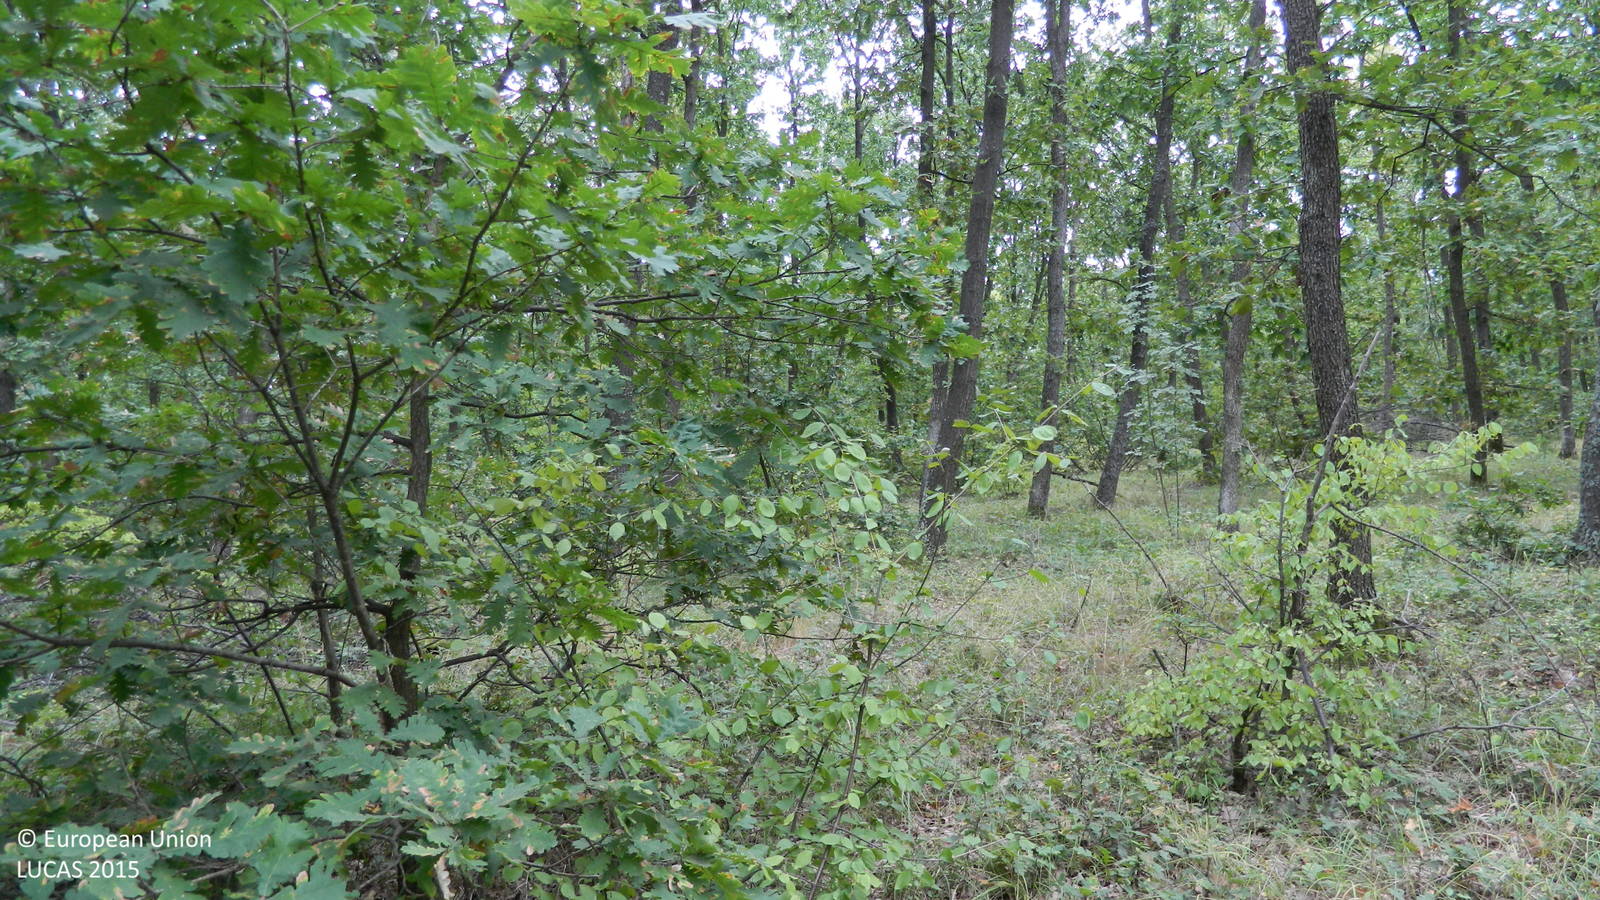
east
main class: Woodland
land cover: Broadleaved woodland
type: mesophytic deciduous forest
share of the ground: > 75 %
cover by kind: broadleaved forest trees 85 %, herbaceous plants 10 %, shrubs 5 %
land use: Forestry
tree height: > 5 m
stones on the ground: < 10 %
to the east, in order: Broadleaved woodland
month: September
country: BG
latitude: 41.7358
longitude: 25.6824
